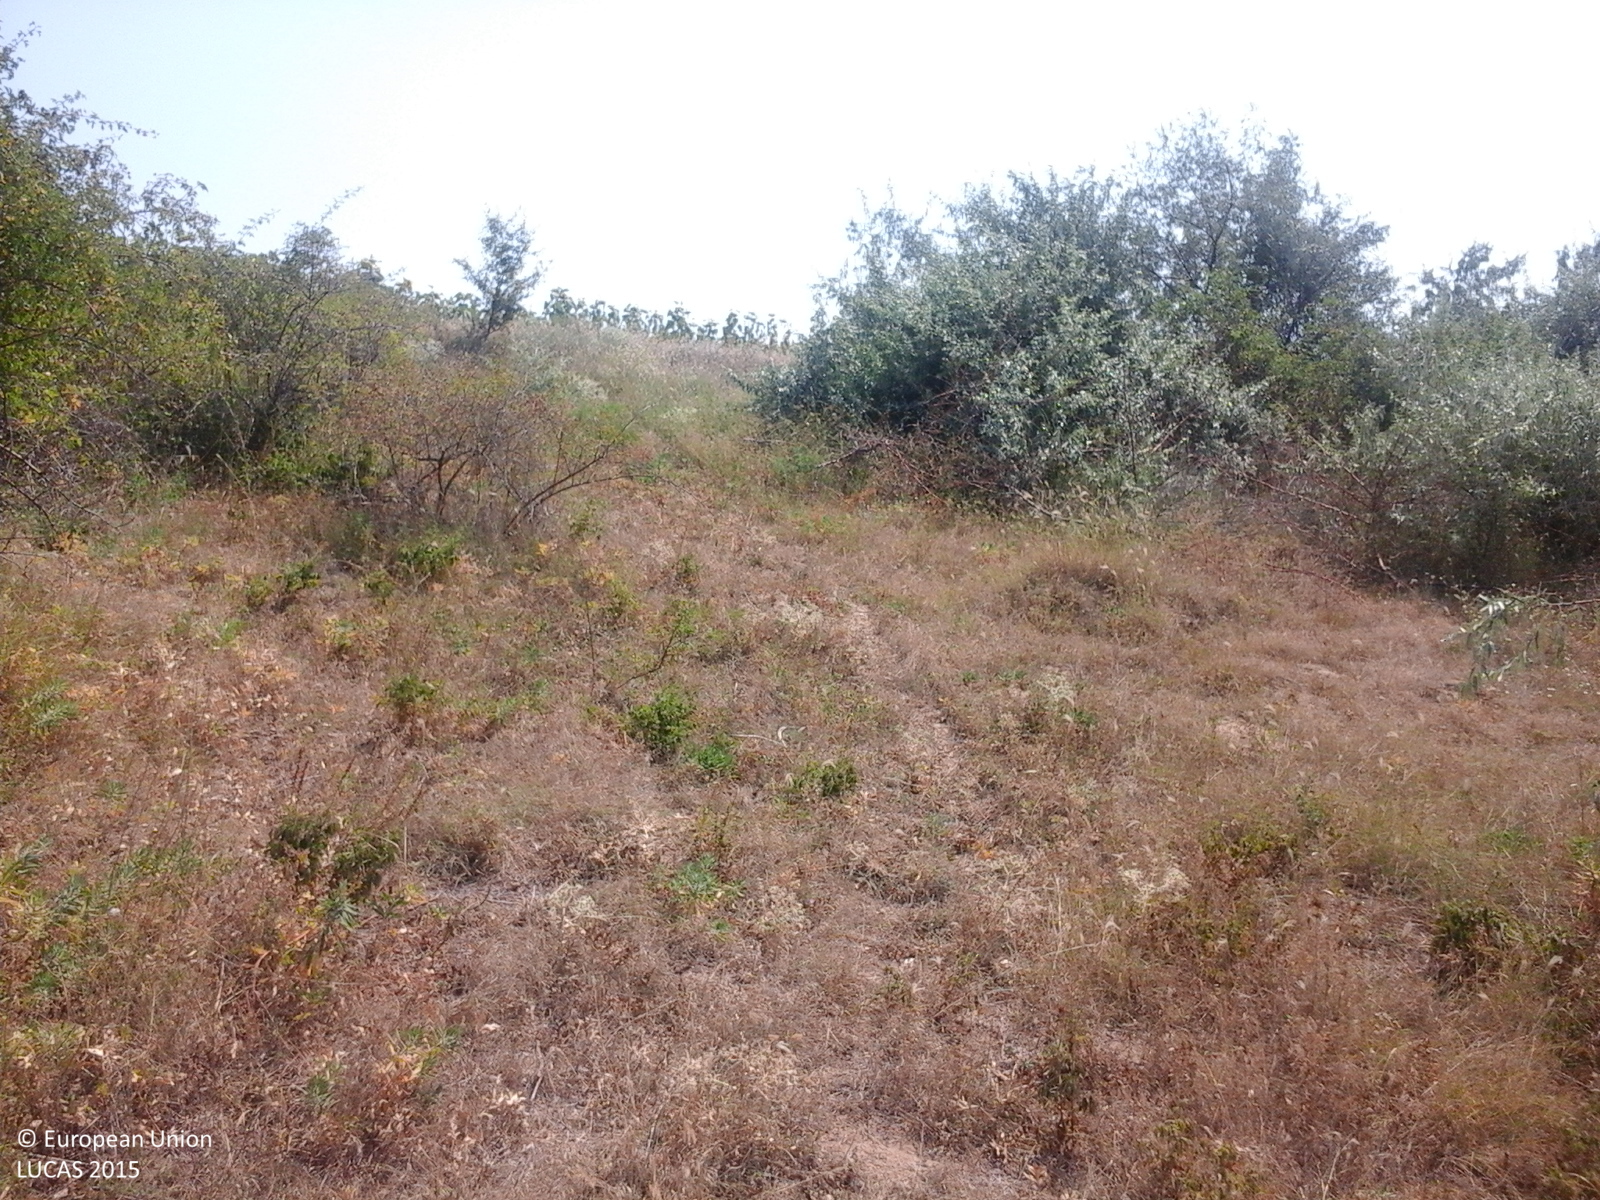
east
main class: Grassland
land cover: Grassland with sparse tree/shrub cover
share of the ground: > 75 %
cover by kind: herbaceous plants 95 %, broadleaved forest trees 5 %
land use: Semi-natural and natural areas not in use
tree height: < 5 m
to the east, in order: Grassland with sparse tree/shrub cover; Shrubland with sparse tree cover; Sunflower
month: July
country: RO
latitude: 45.9613
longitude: 27.9396
